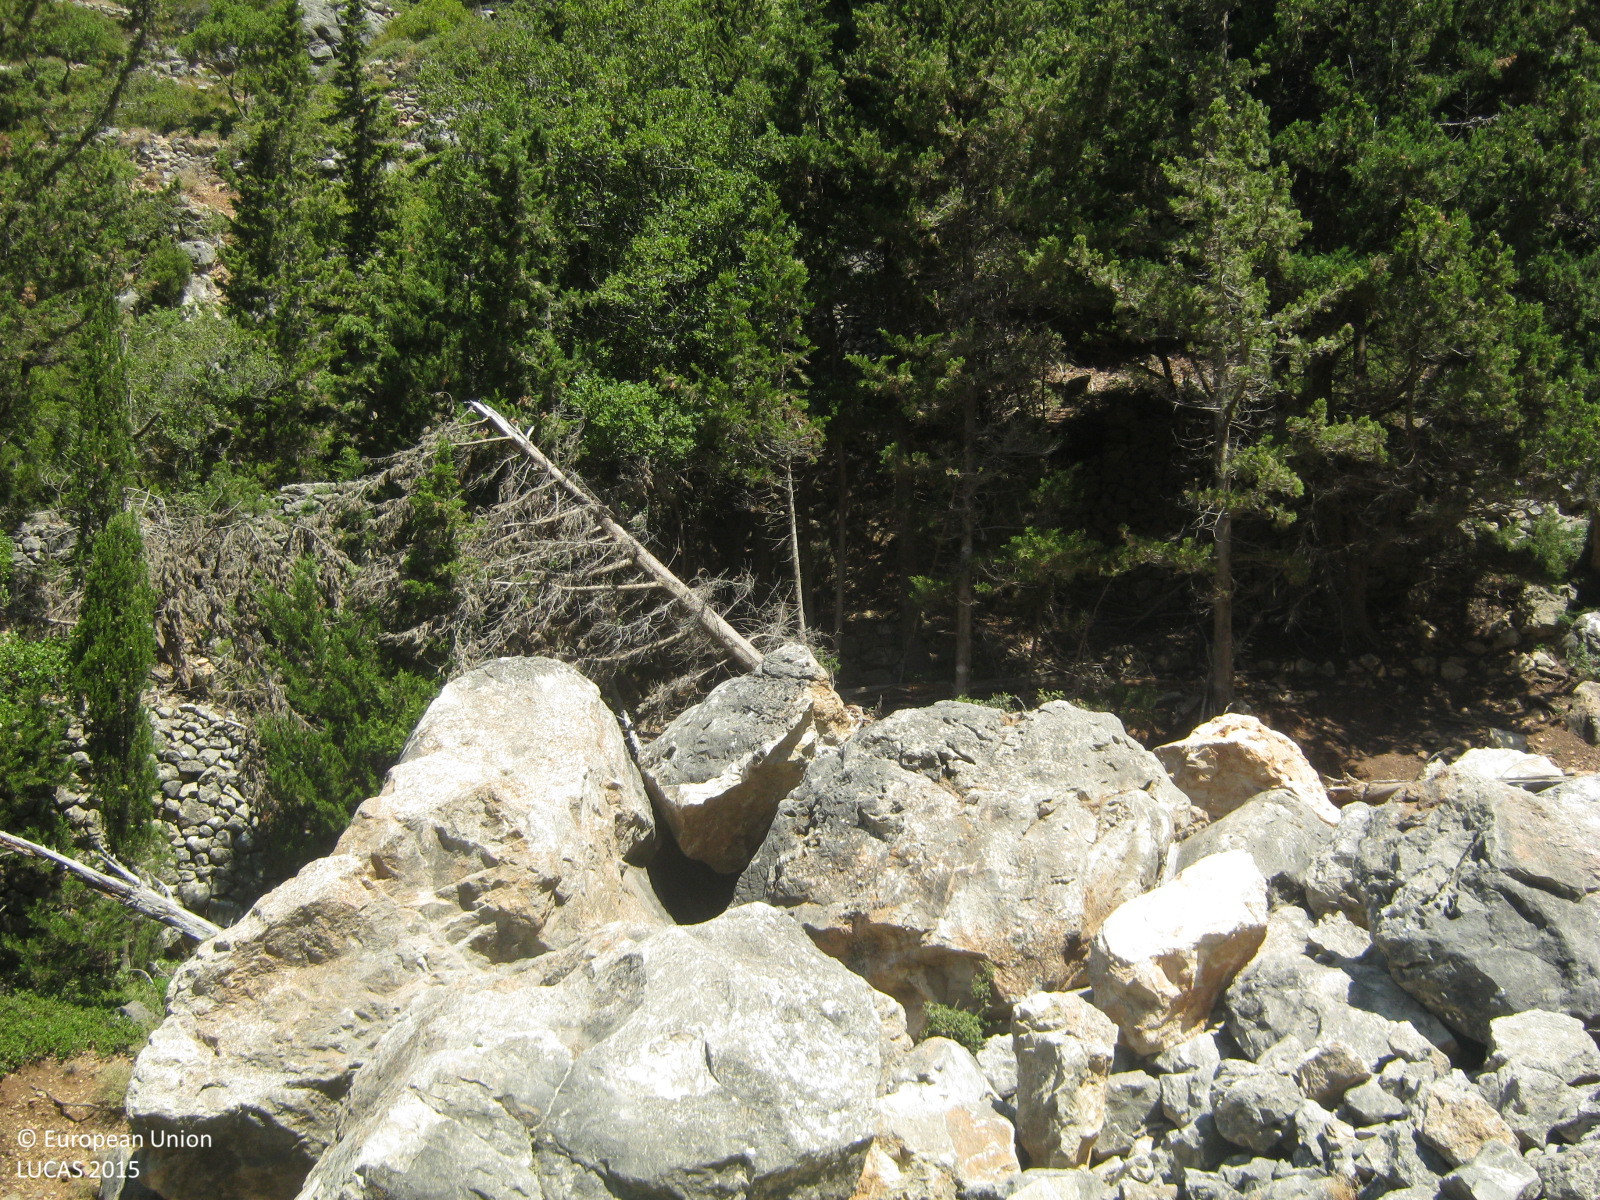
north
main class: Woodland
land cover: Other coniferous woodland
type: mesophytic deciduous forest
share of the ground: 25 - 50 %
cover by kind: consolidated bare surface 35 %, coniferous forest trees 30 %, herbaceous plants 25 %, shrubs 10 %
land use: Semi-natural and natural areas not in use
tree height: > 5 m
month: July
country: GR
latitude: 38.3828
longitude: 20.5525
